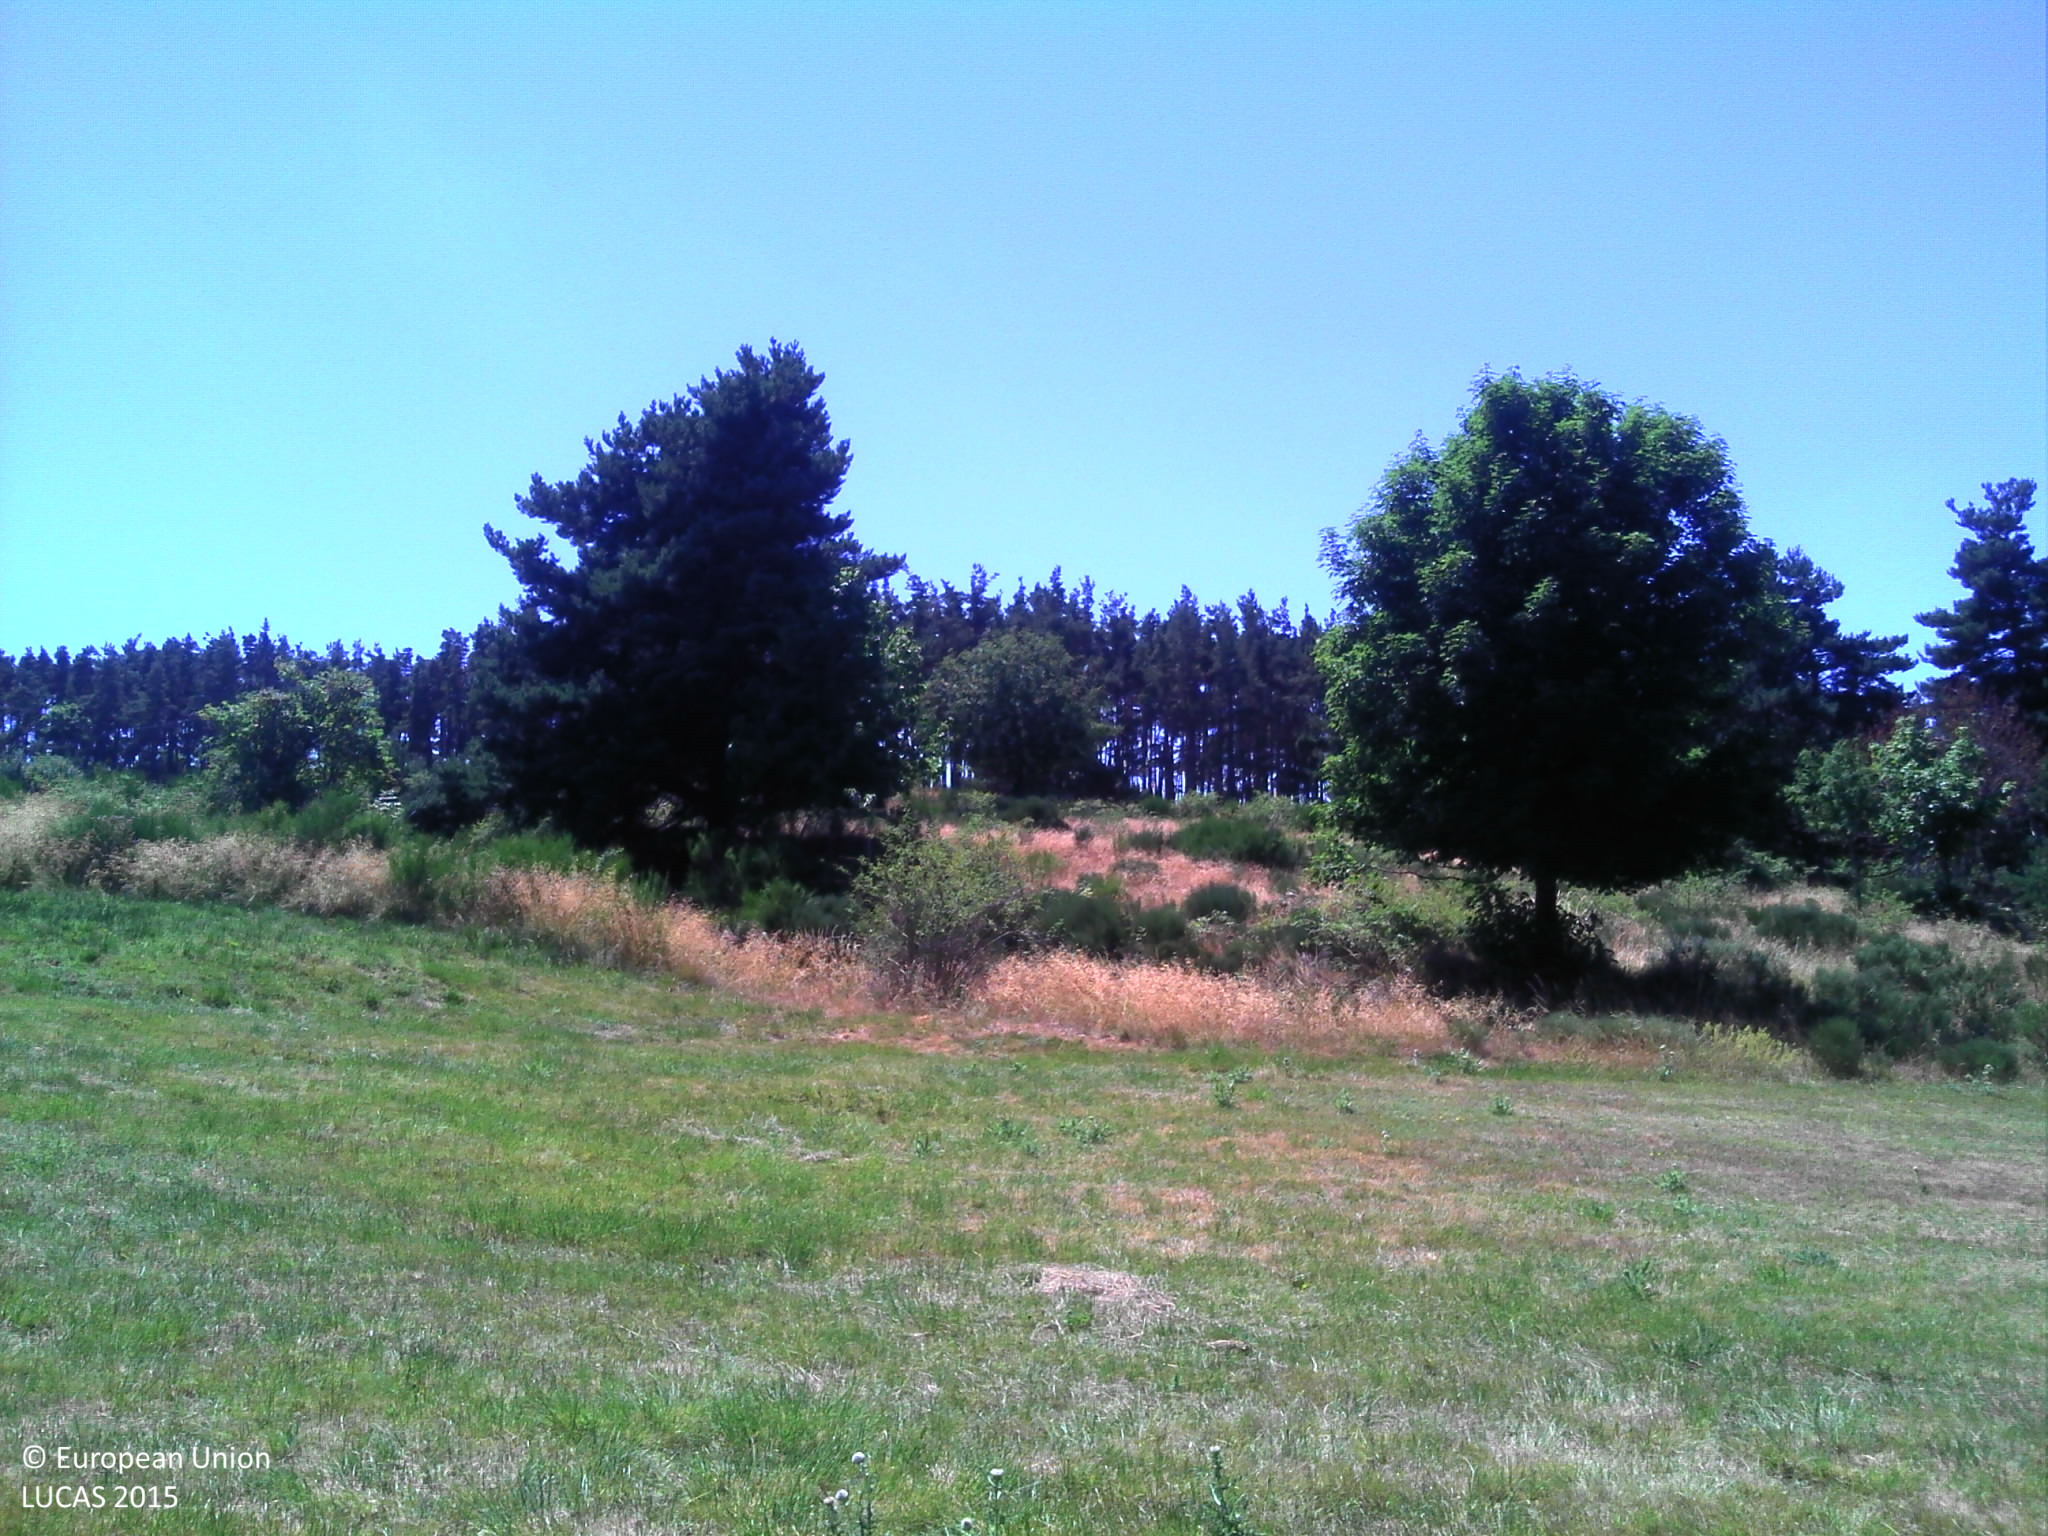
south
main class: Grassland
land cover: Grassland without tree/shrub cover
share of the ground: > 75 %
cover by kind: herbaceous plants 95 %, shrubs 5 %
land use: Agriculture (excluding fallow land and kitchen gardens)
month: July
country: FR
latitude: 44.7404
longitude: 3.4498
